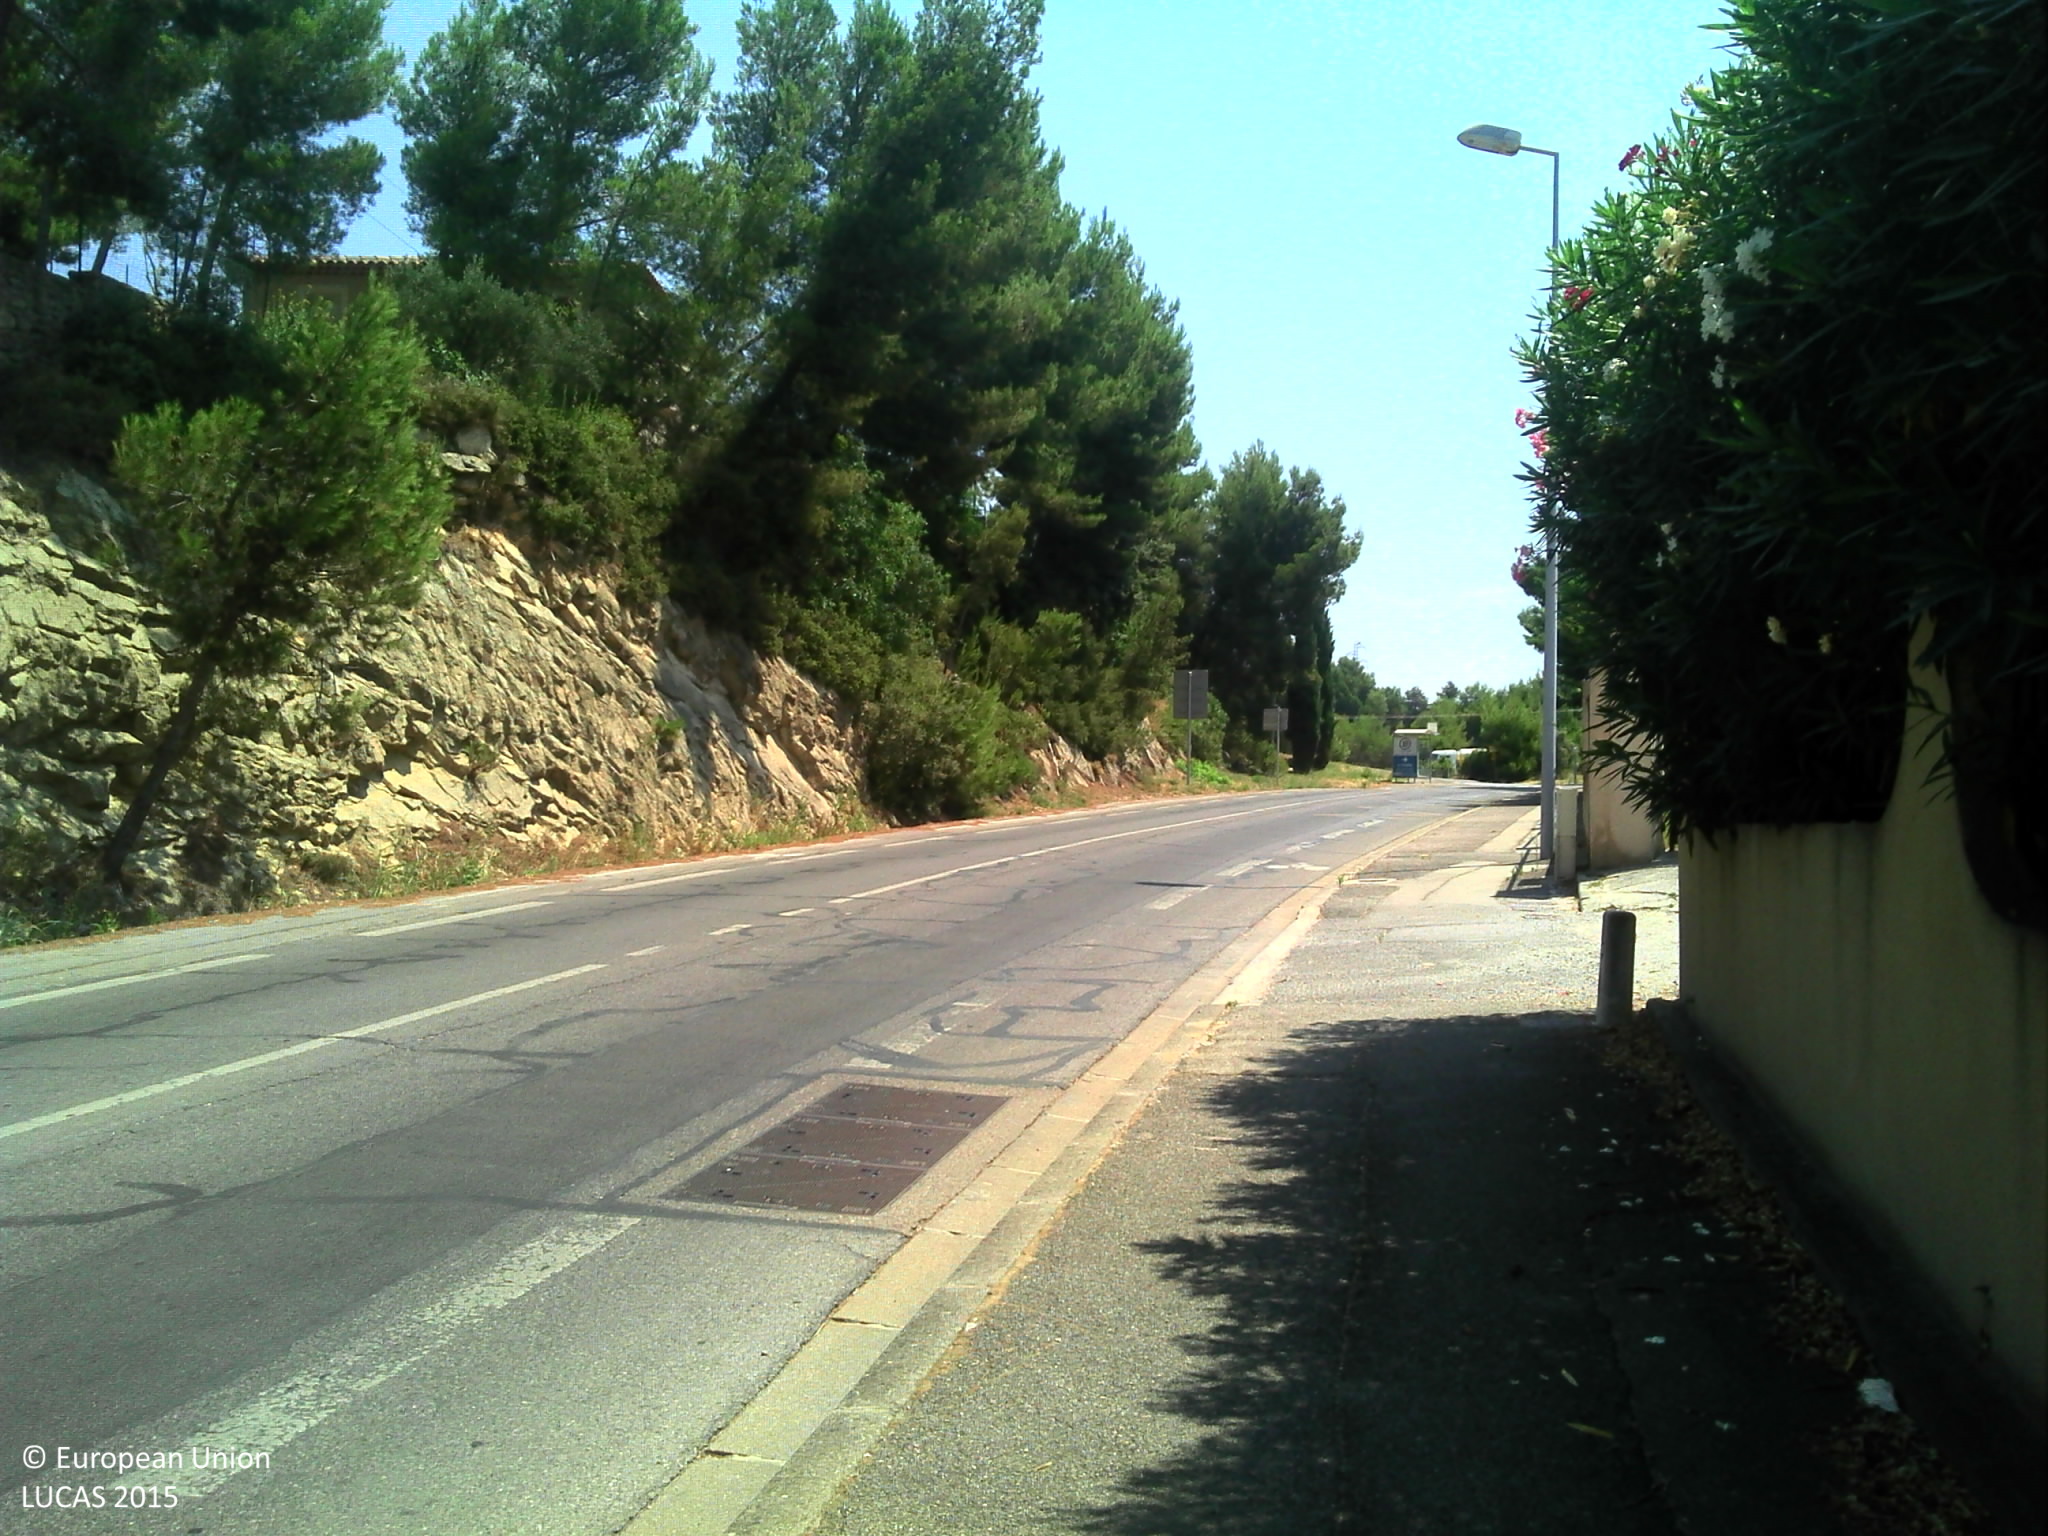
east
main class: Woodland
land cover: Pine dominated coniferous woodland
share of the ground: 25 - 50 %
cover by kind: coniferous forest trees 20 %, shrubs 10 %, herbaceous plants 10 %
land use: Residential
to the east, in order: Pine dominated coniferous woodland; Artificial constructions in urban areas; Inland fresh running water; Tracks; Electric lines; Pine dominated coniferous woodland; Paved roads, cycling and walking lanes
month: July
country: FR
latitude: 43.6391
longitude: 5.1131
